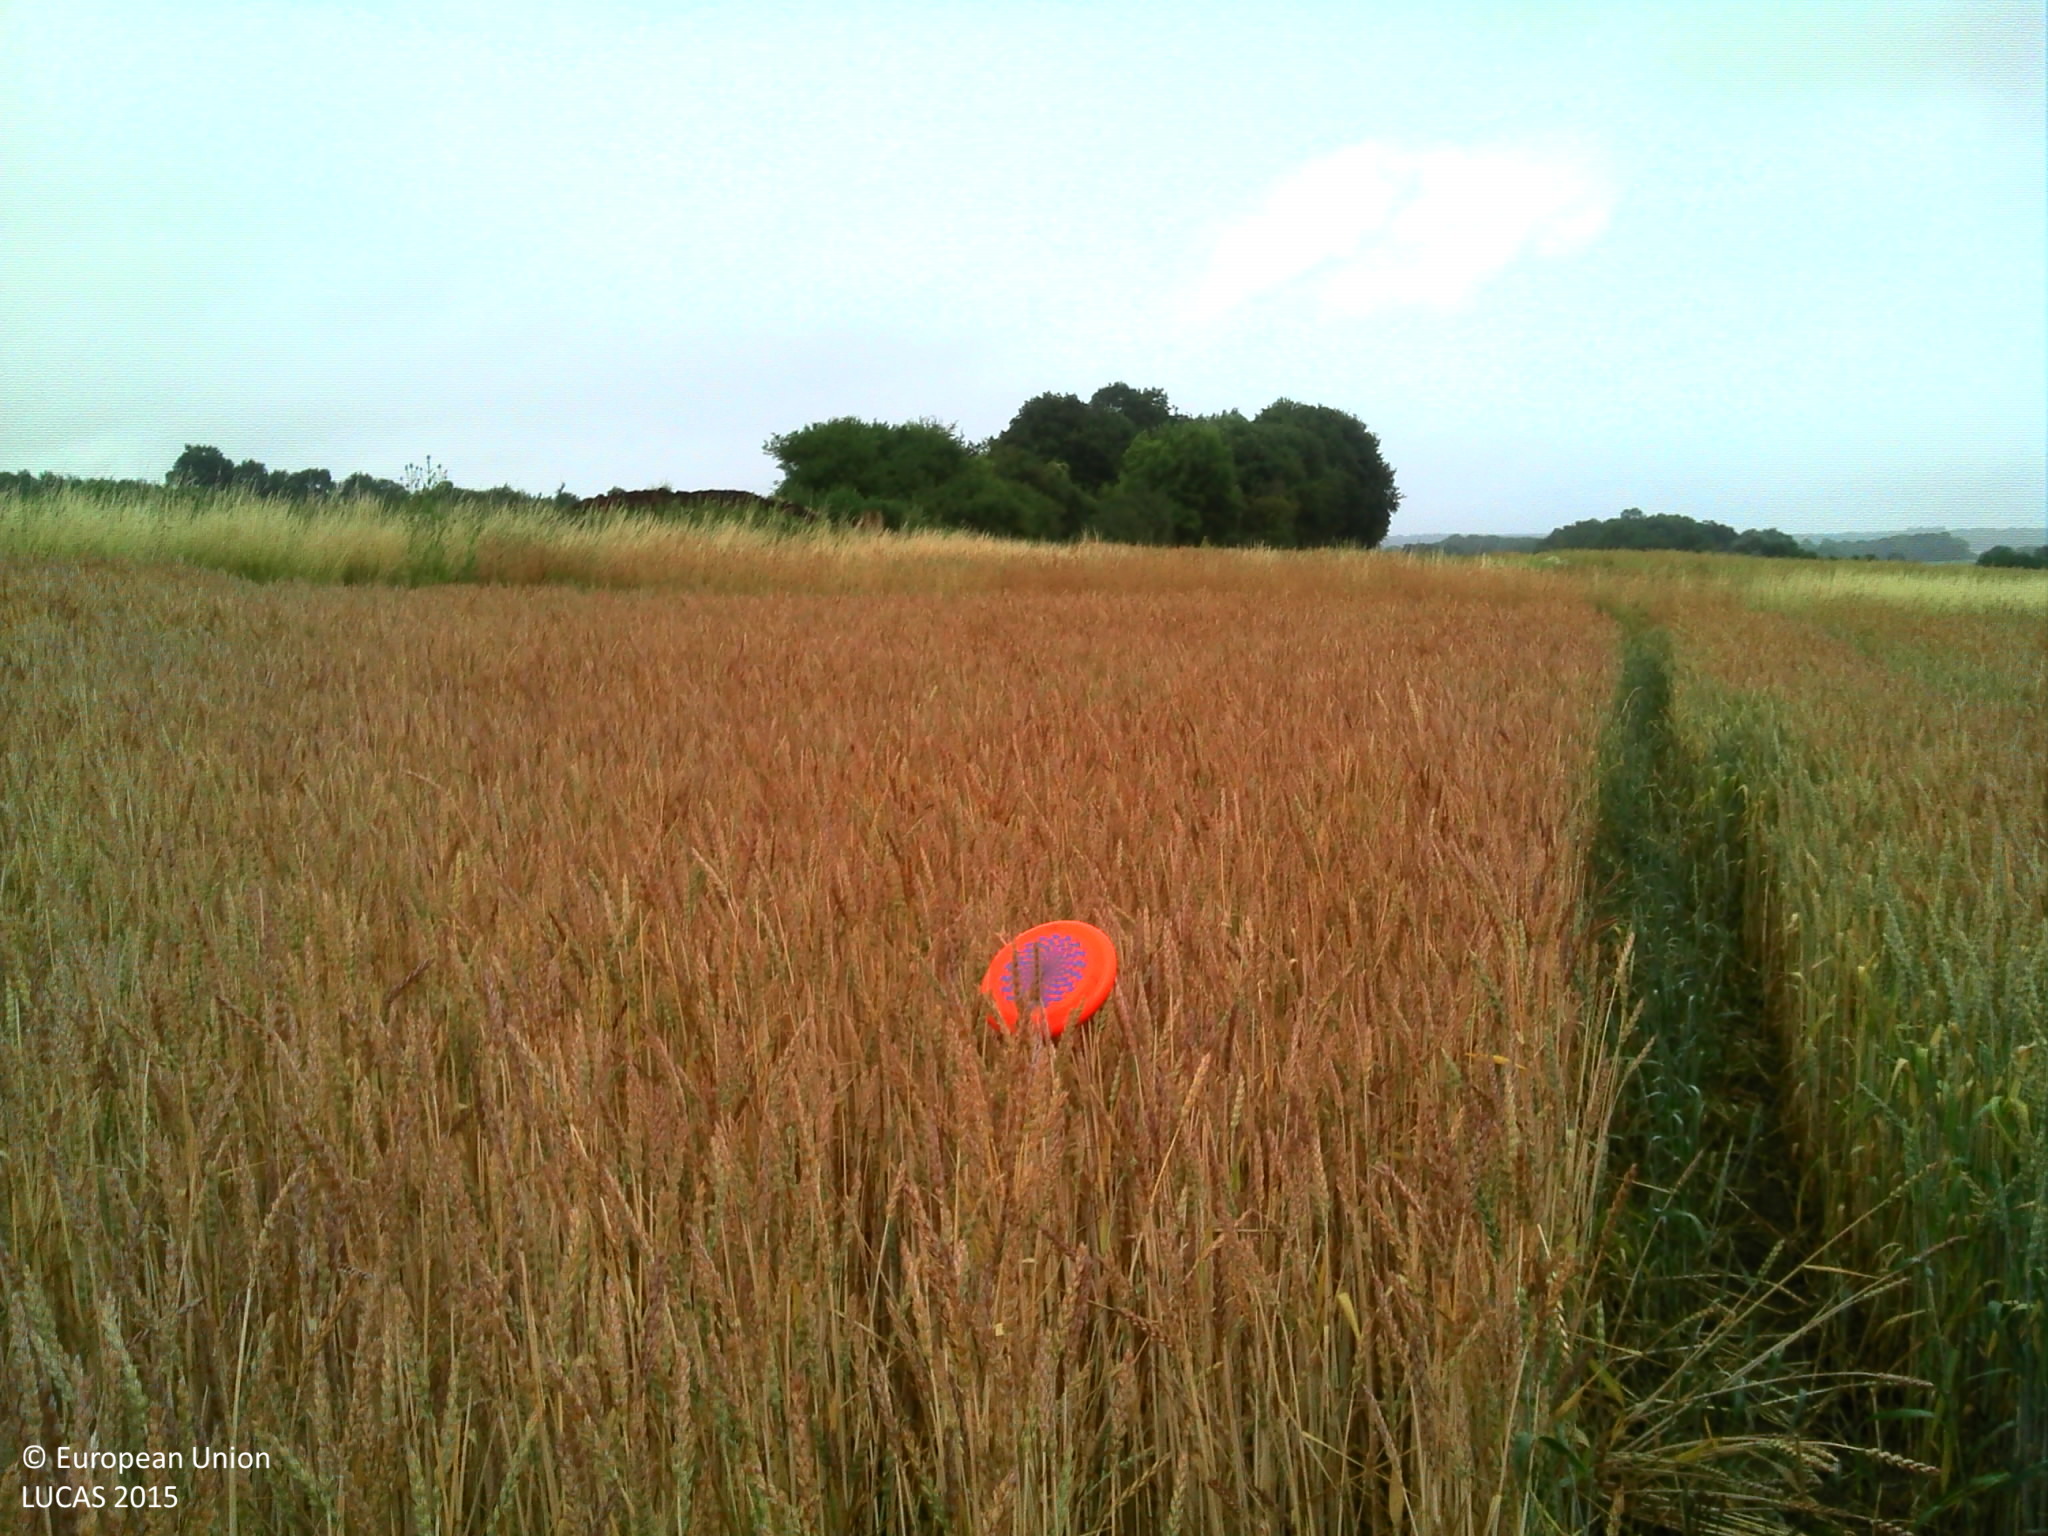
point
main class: Cropland
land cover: Common wheat
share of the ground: > 75 %
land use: Agriculture (excluding fallow land and kitchen gardens)
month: July
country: BE
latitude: 50.2794
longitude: 4.3683
